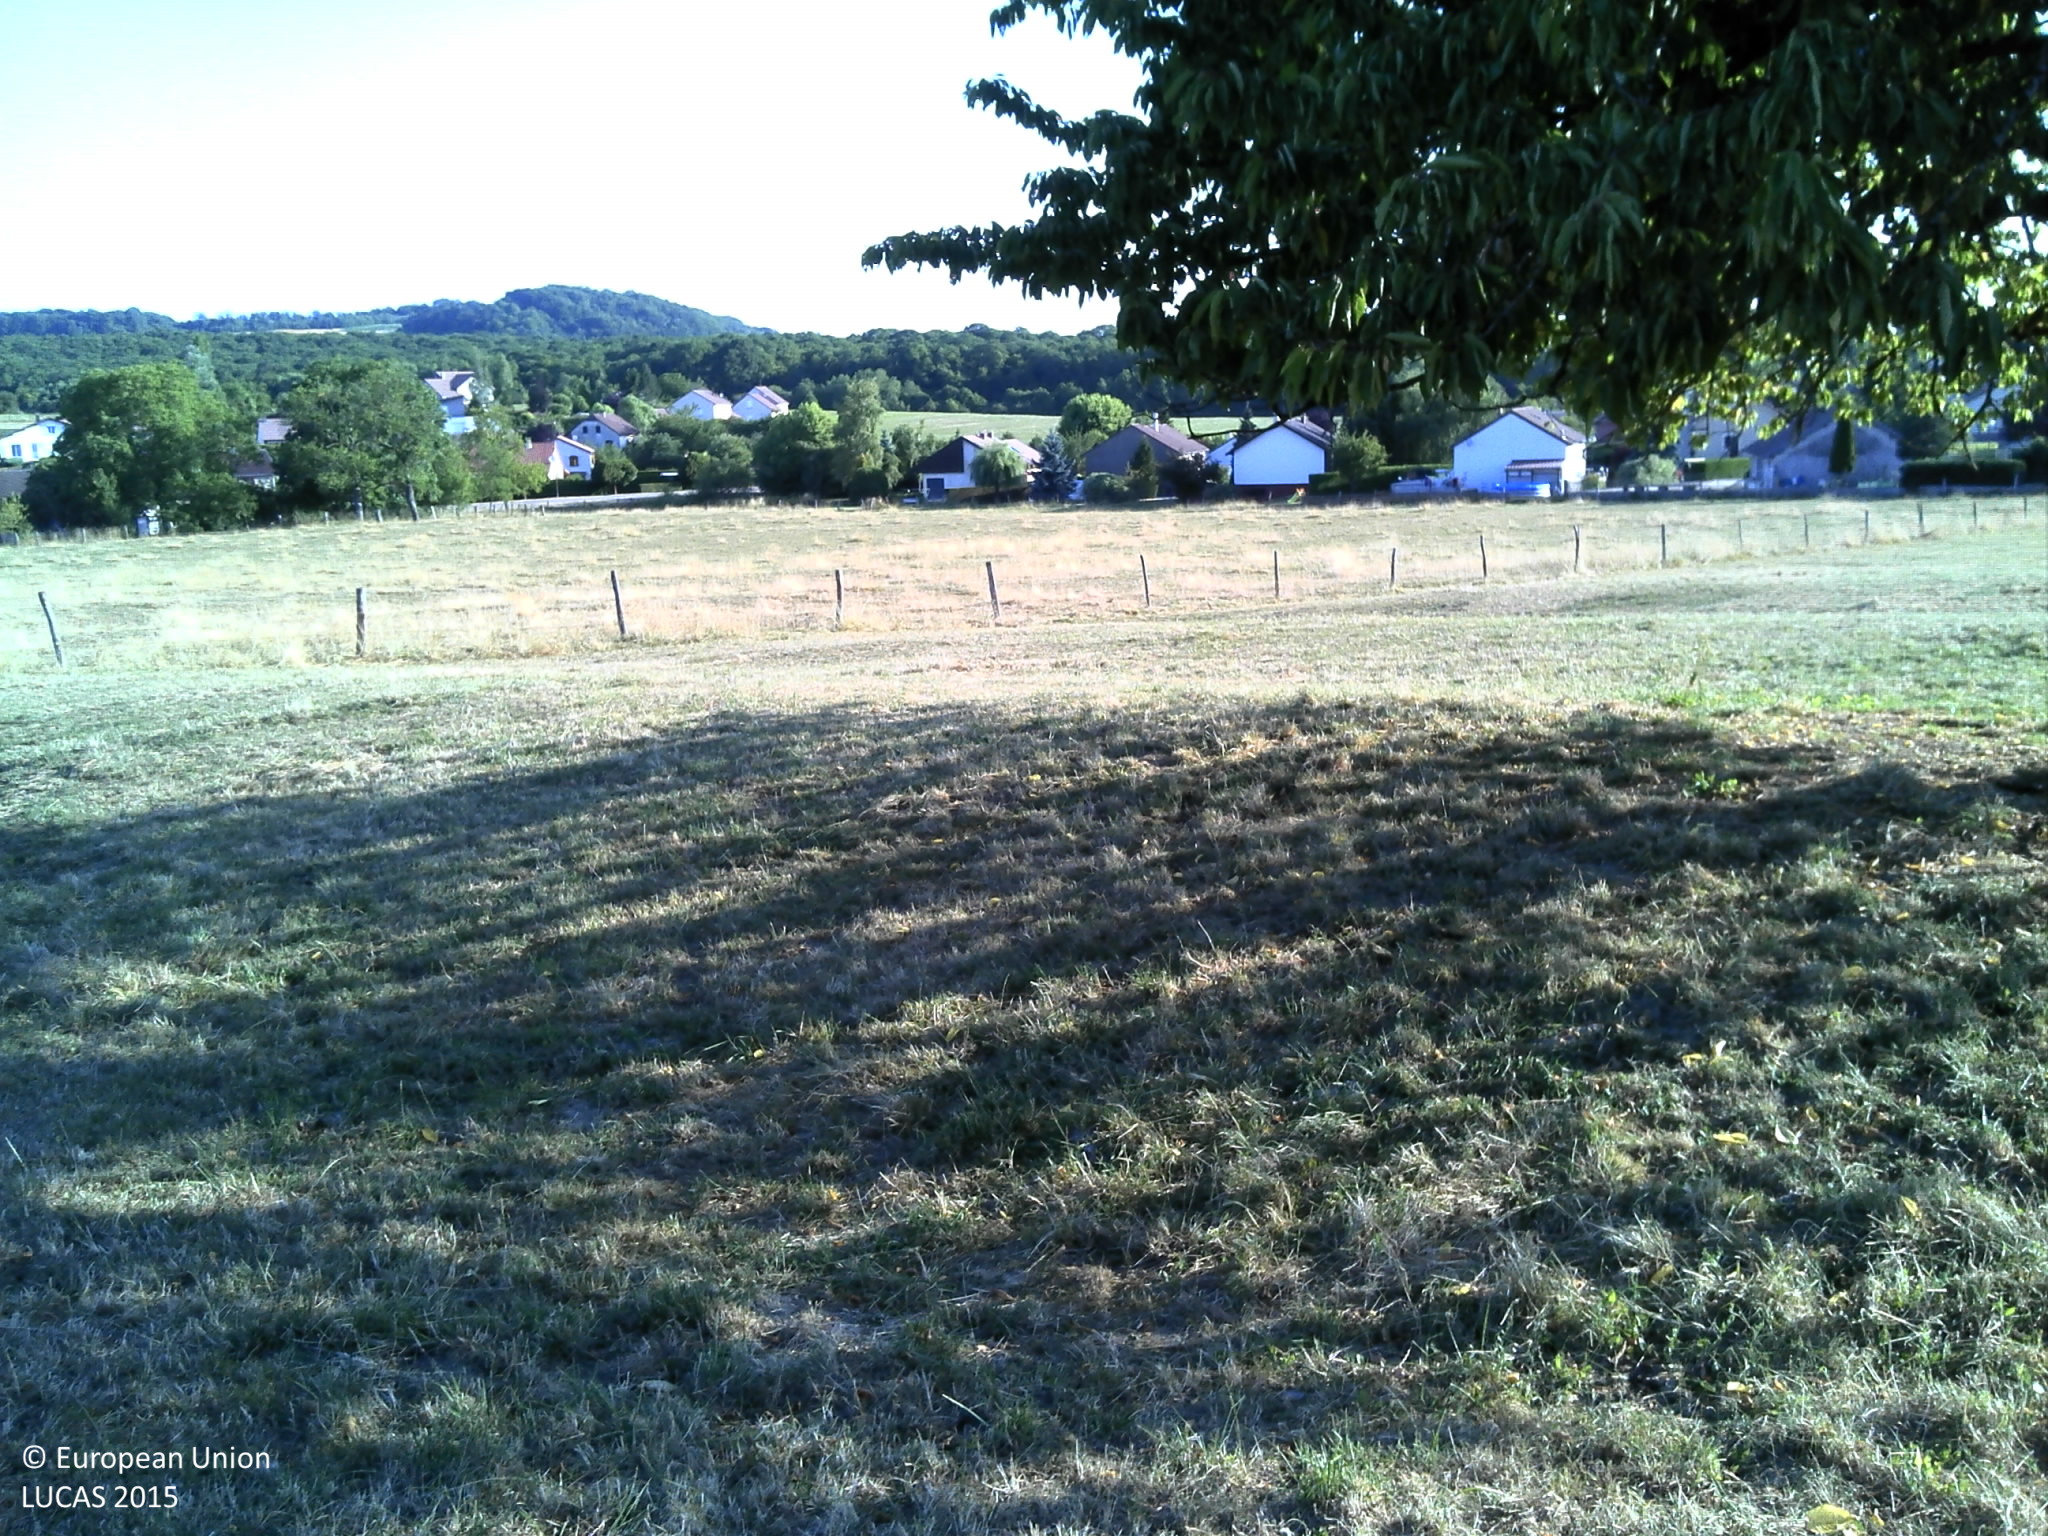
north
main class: Grassland
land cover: Grassland with sparse tree/shrub cover
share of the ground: > 75 %
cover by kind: herbaceous plants 95 %, broadleaved forest trees 5 %
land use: Agriculture (excluding fallow land and kitchen gardens)
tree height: > 5 m
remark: Harvested field
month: July
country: FR
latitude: 48.2052
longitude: 6.0039
